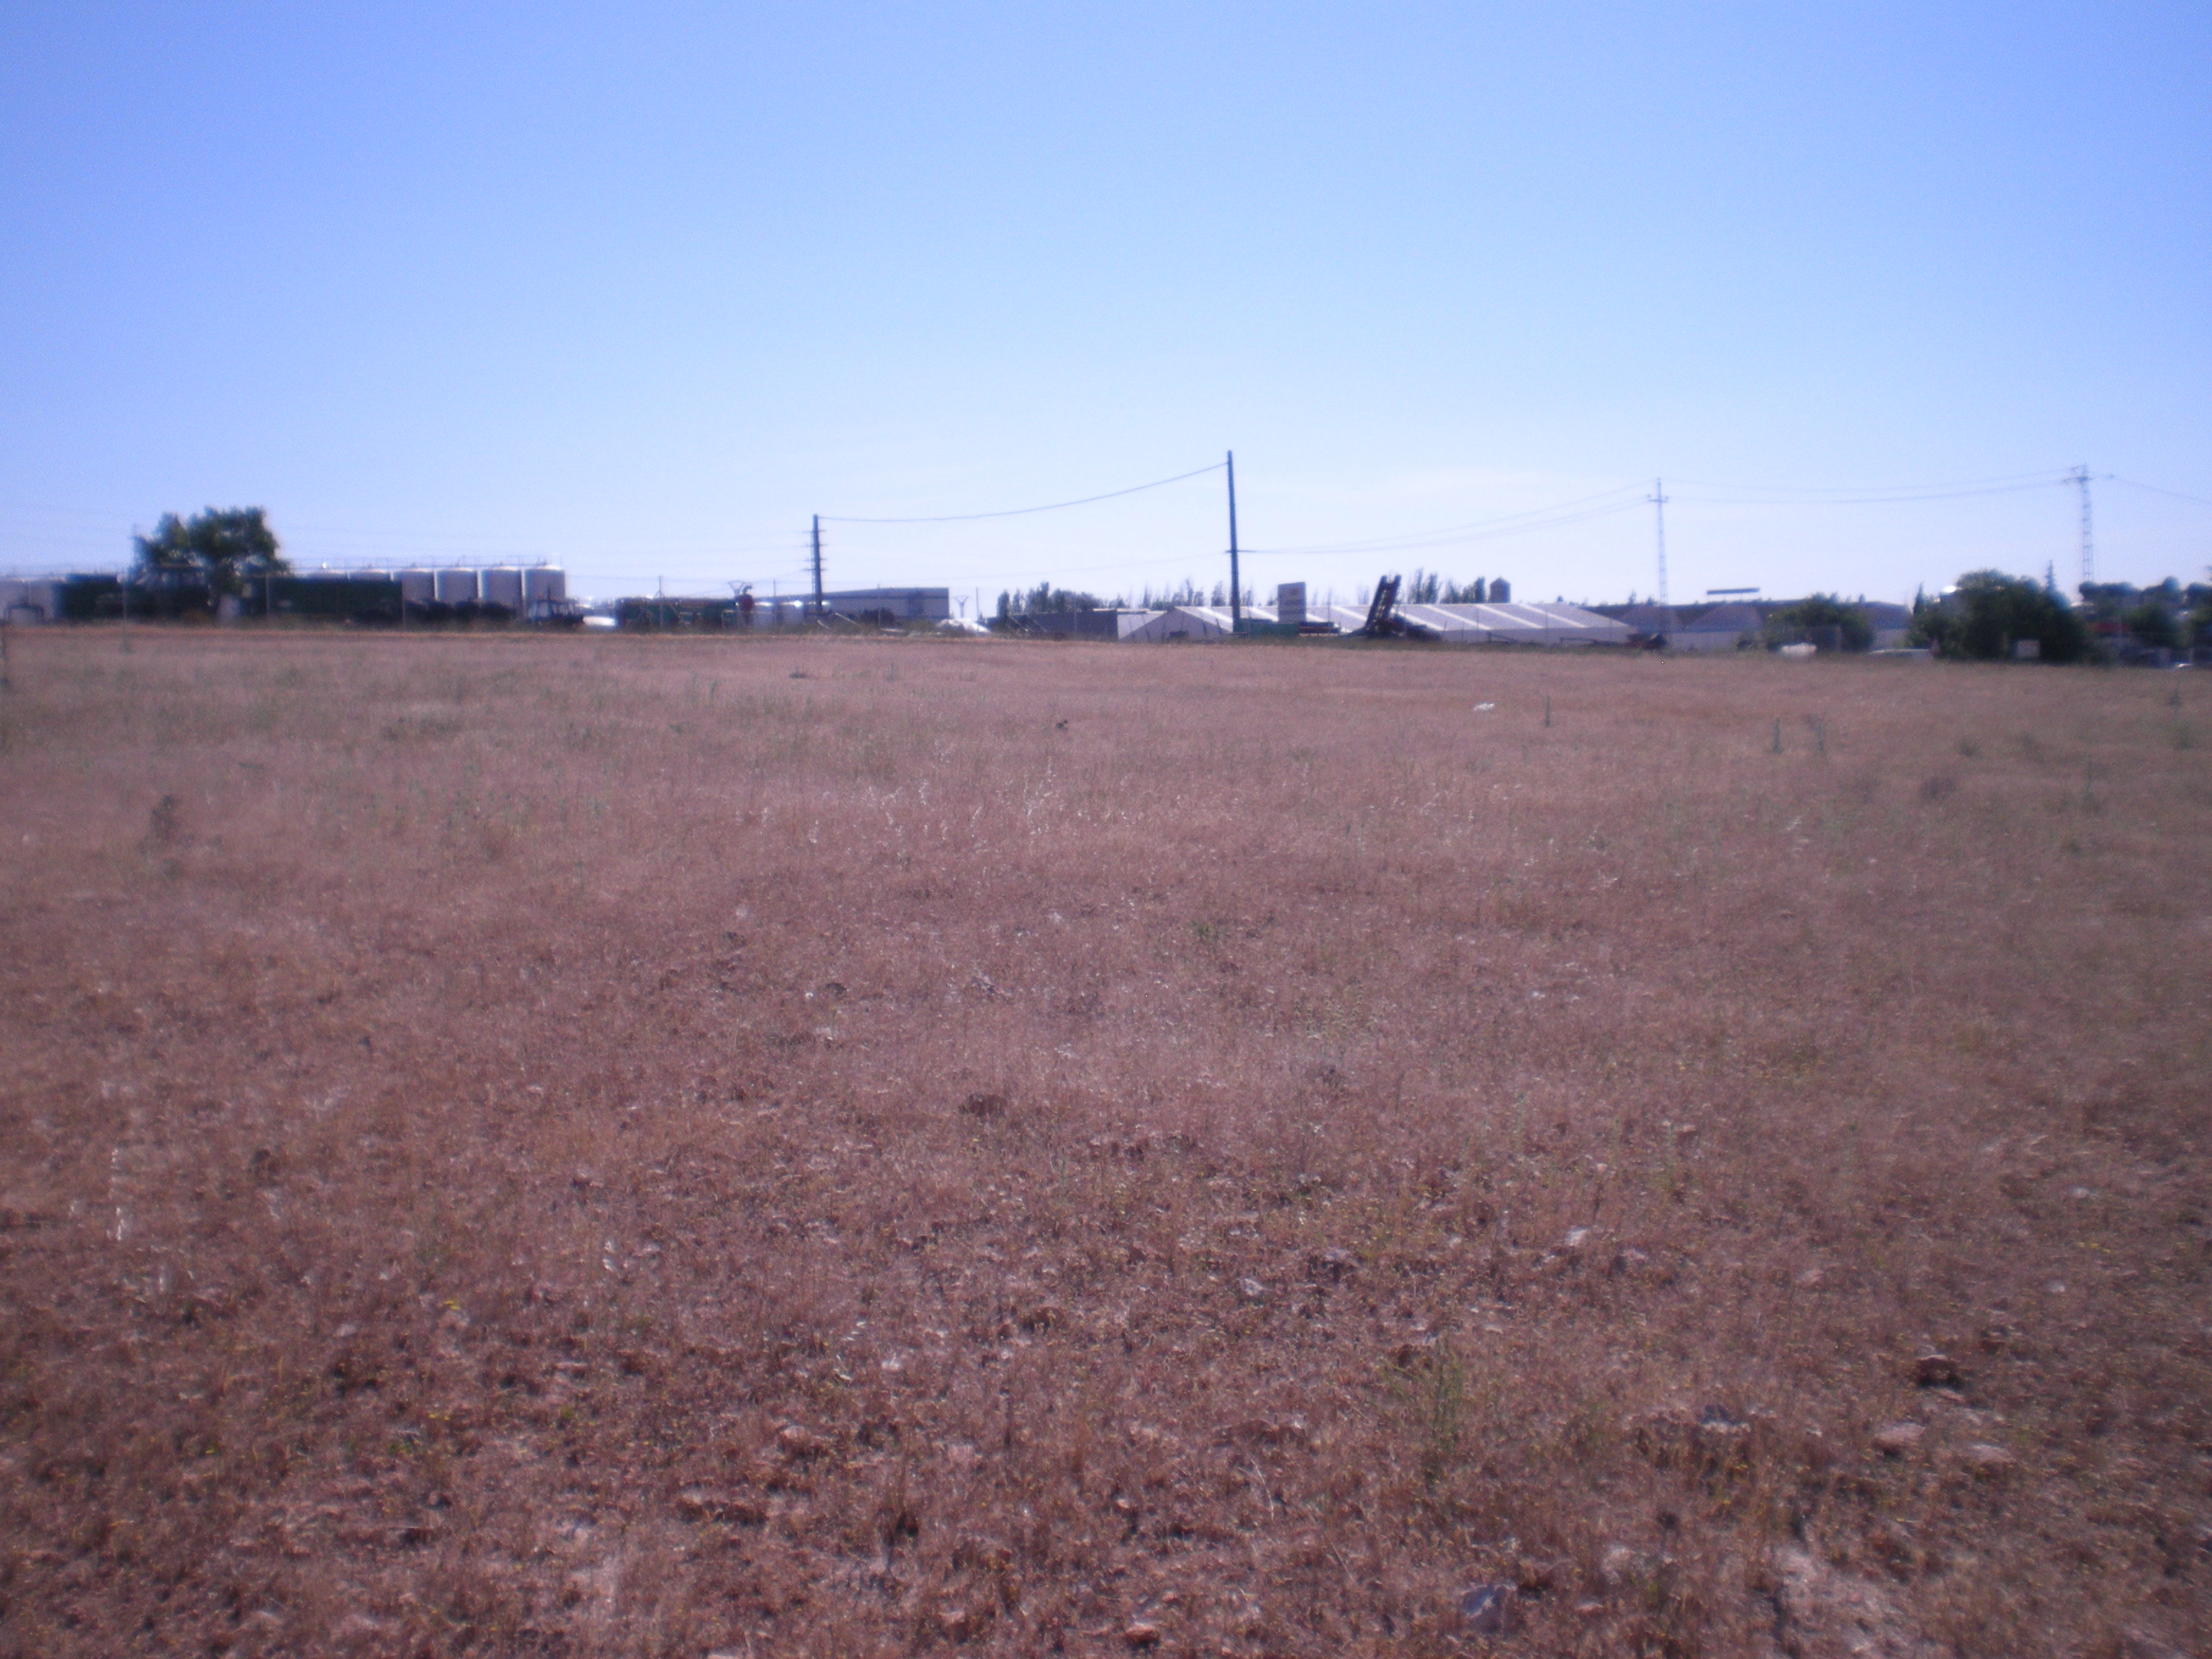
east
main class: Grassland
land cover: Spontaneously vegetated surfaces
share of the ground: 10 - 25 %
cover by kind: unconsolidated bare surface 90 %, herbaceous plants 10 %
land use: Agriculture (excluding fallow land and kitchen gardens)
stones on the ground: 10 - 25 %
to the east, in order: Spontaneously vegetated surfaces; Grass margins; Tracks; Grass margins; Fences; Spontaneously vegetated surfaces; Electric lines; Spontaneously vegetated surfaces; Fences; Grass margins; Paved roads, cycling and walking lanes; Grass margins; Spontaneously vegetated surfaces; Grass margins; Artificial constructions in urban areas
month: May
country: ES
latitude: 39.0772
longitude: -3.6000
